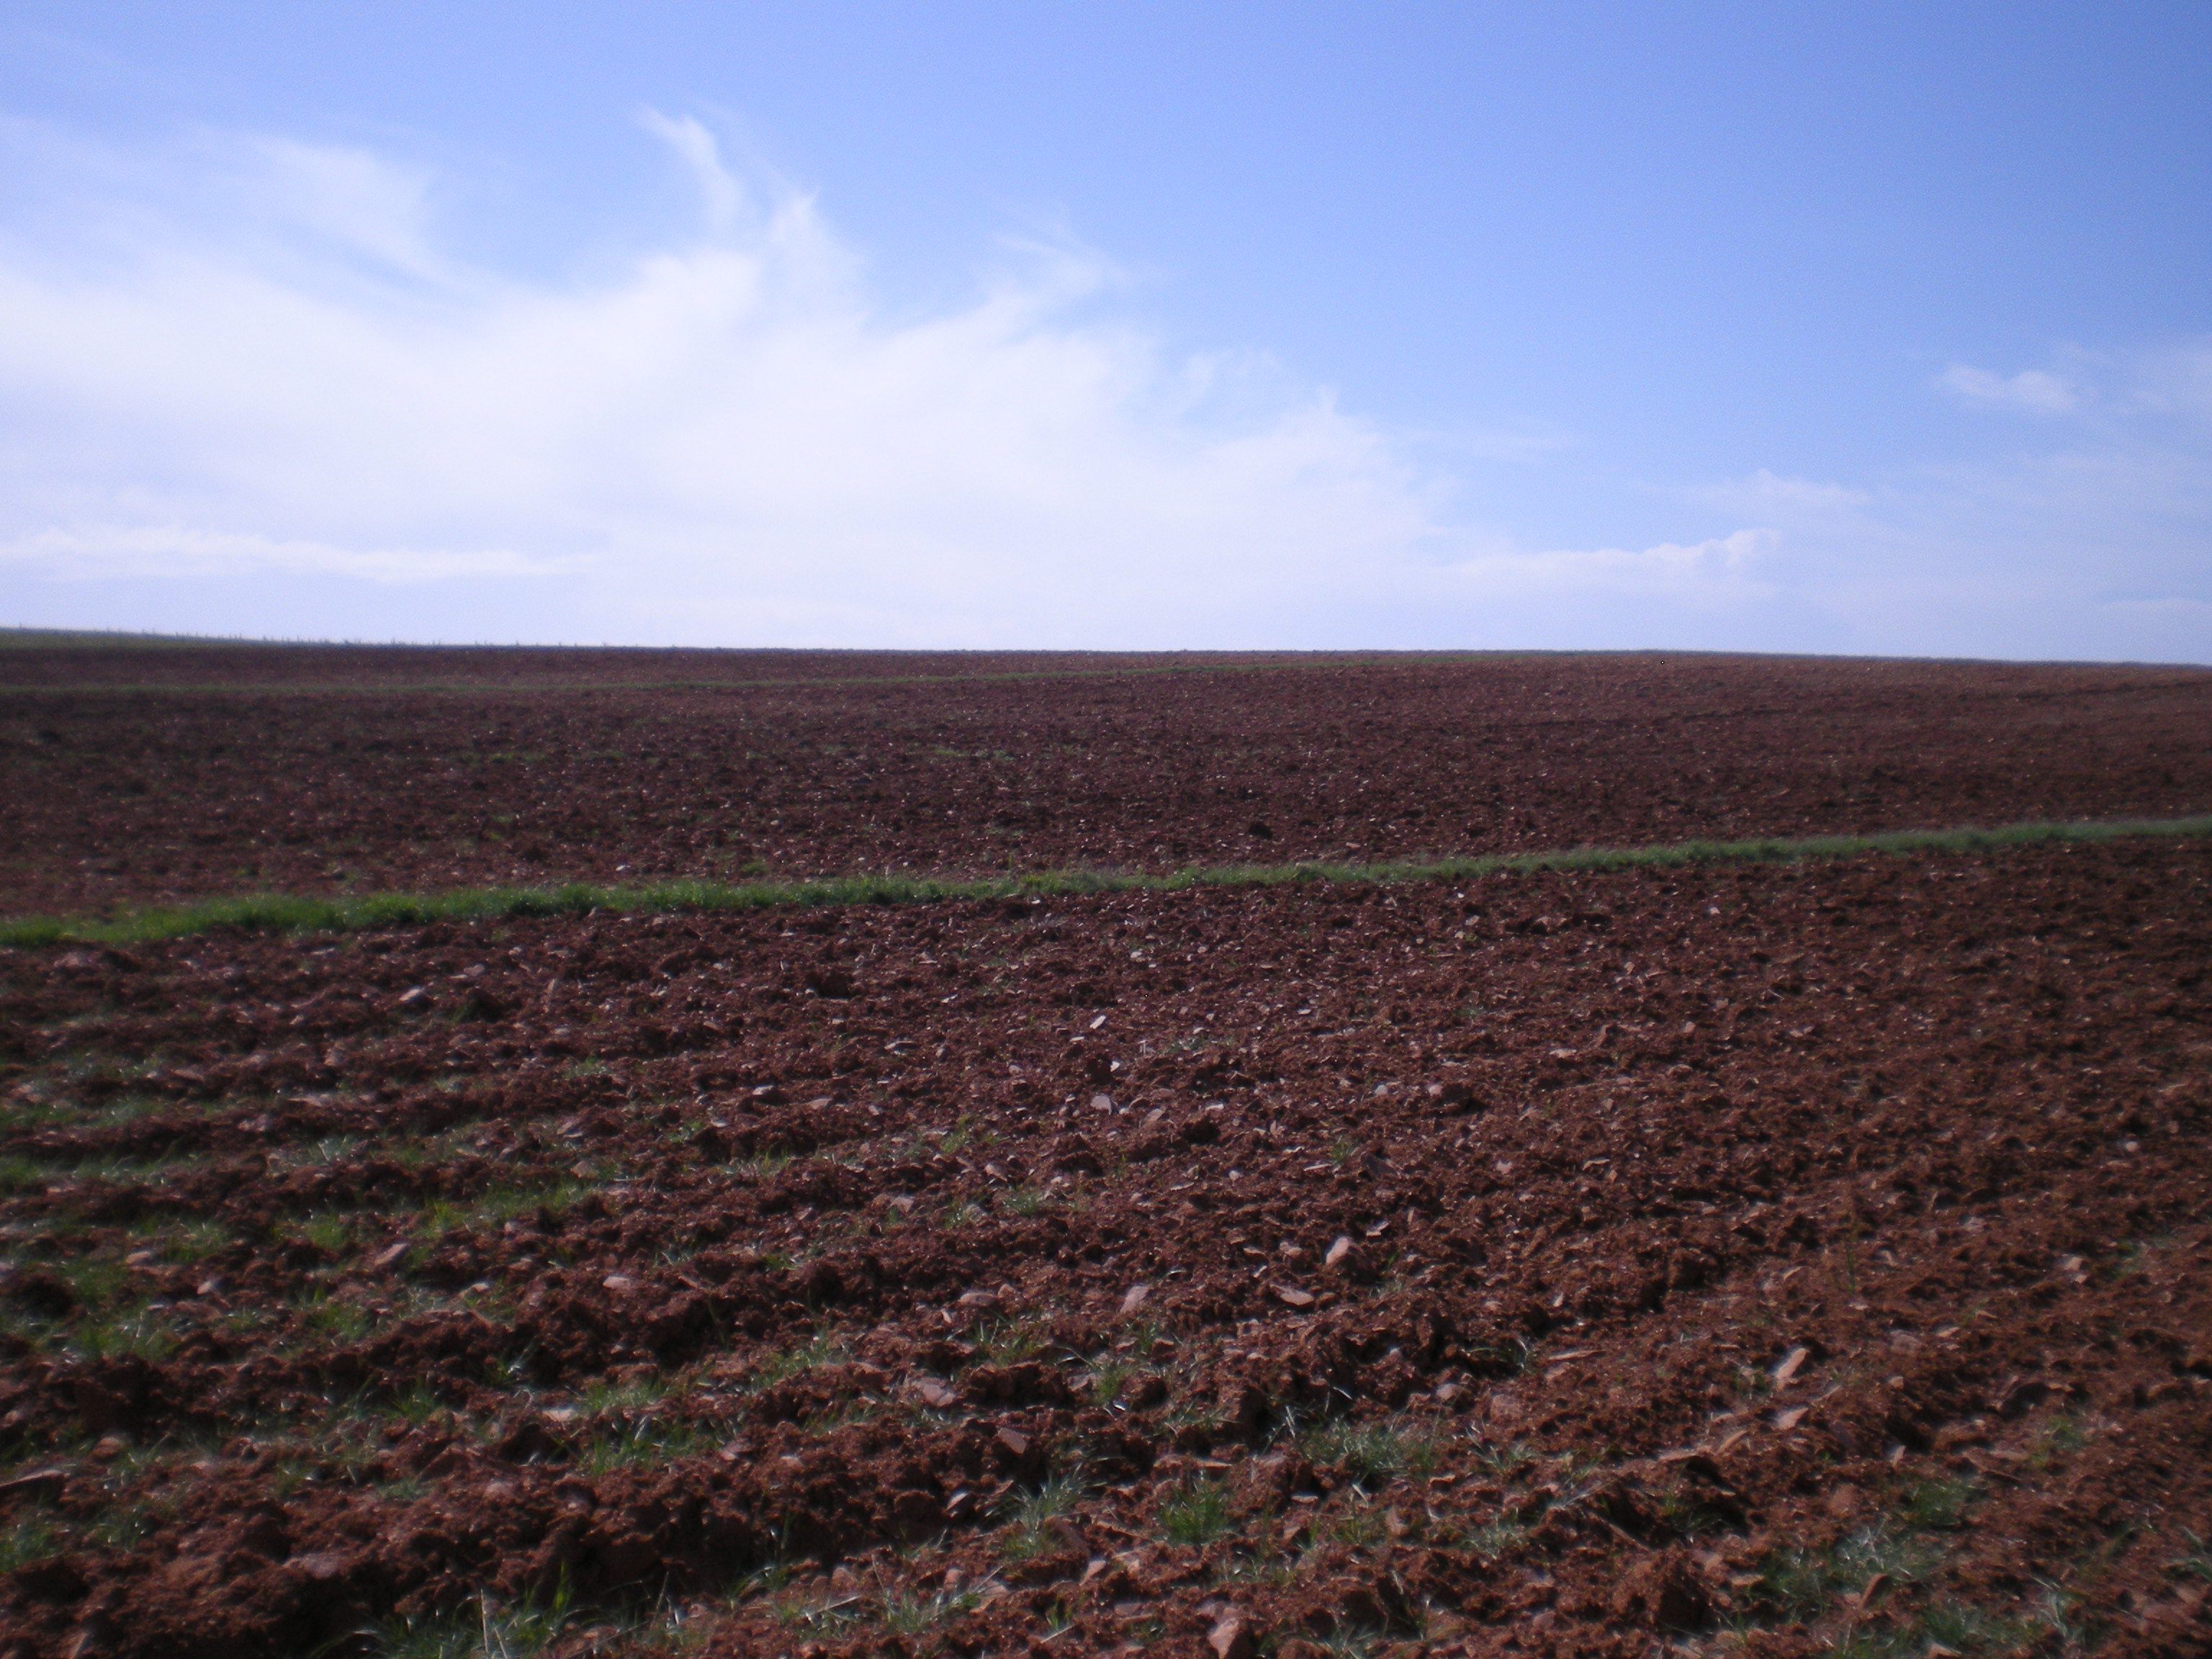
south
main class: Grassland
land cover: Spontaneously vegetated surfaces
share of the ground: 10 - 25 %
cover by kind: unconsolidated bare surface 80 %, herbaceous plants 20 %
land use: Fallow land
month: April
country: ES
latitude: 38.5219
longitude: -3.5089
